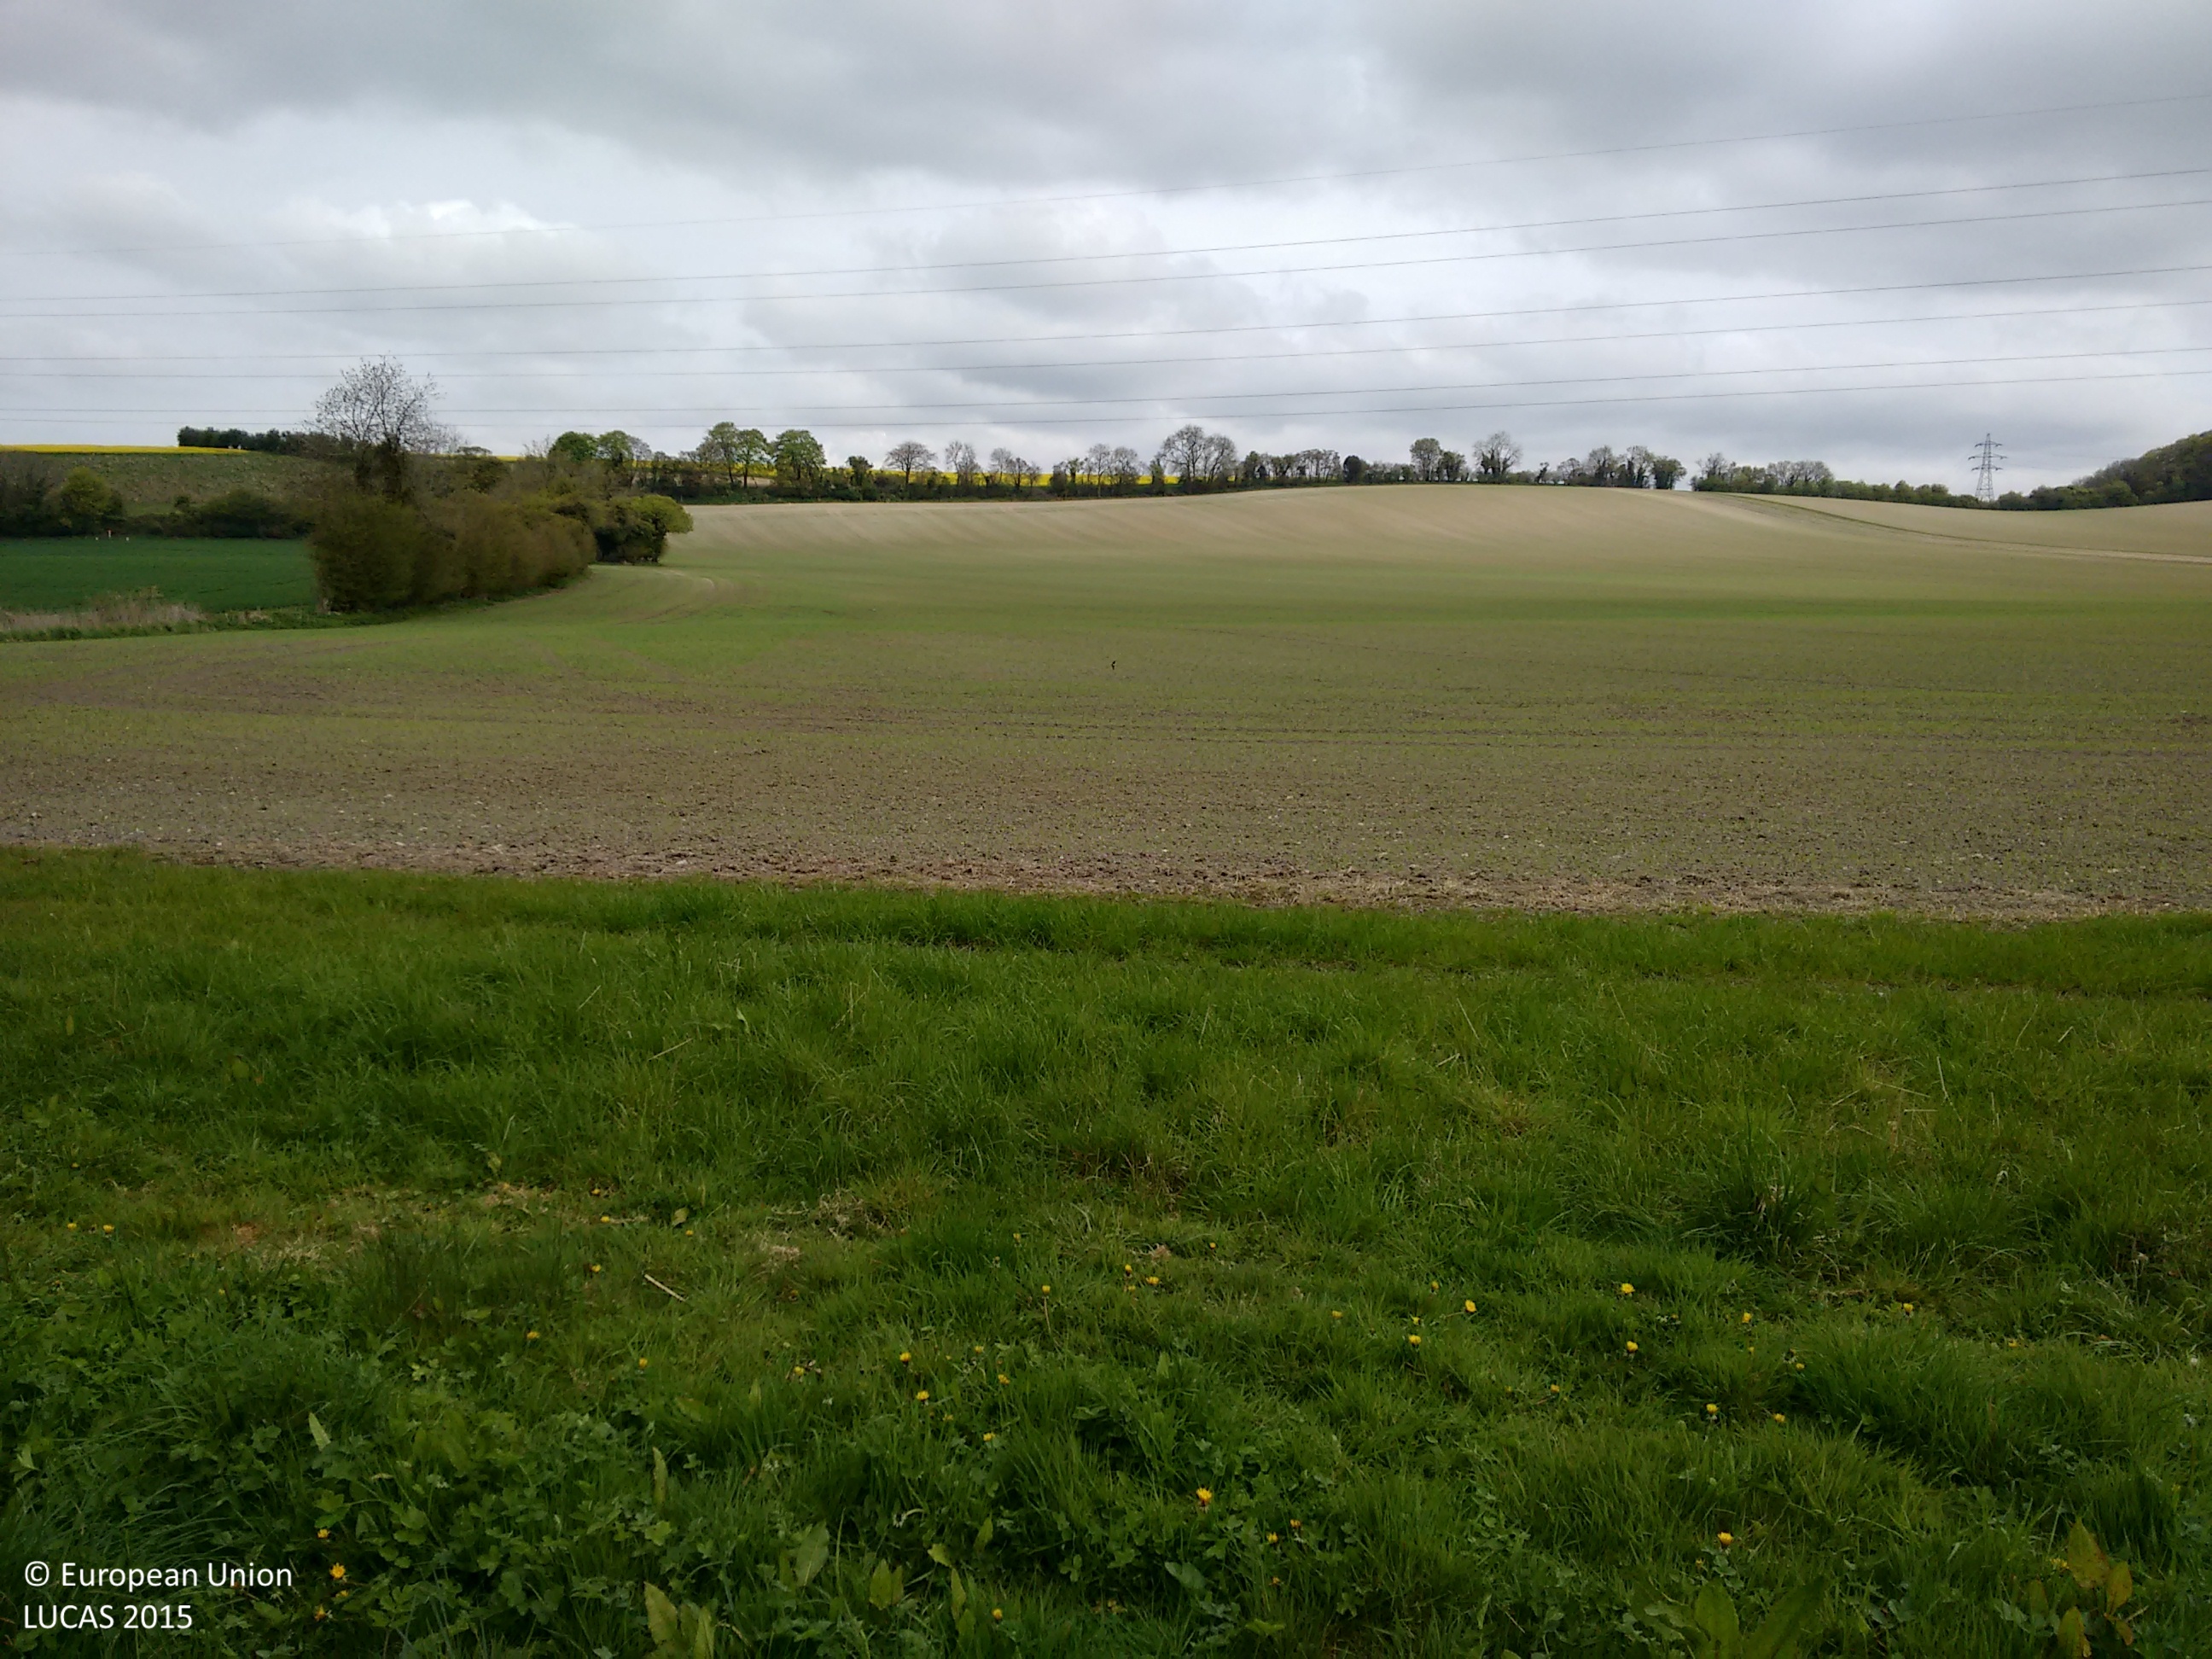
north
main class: Grassland
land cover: Grassland without tree/shrub cover
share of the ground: > 75 %
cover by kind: herbaceous plants 100 %
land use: Residential
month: May
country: GB
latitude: 51.1433
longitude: -0.9500
